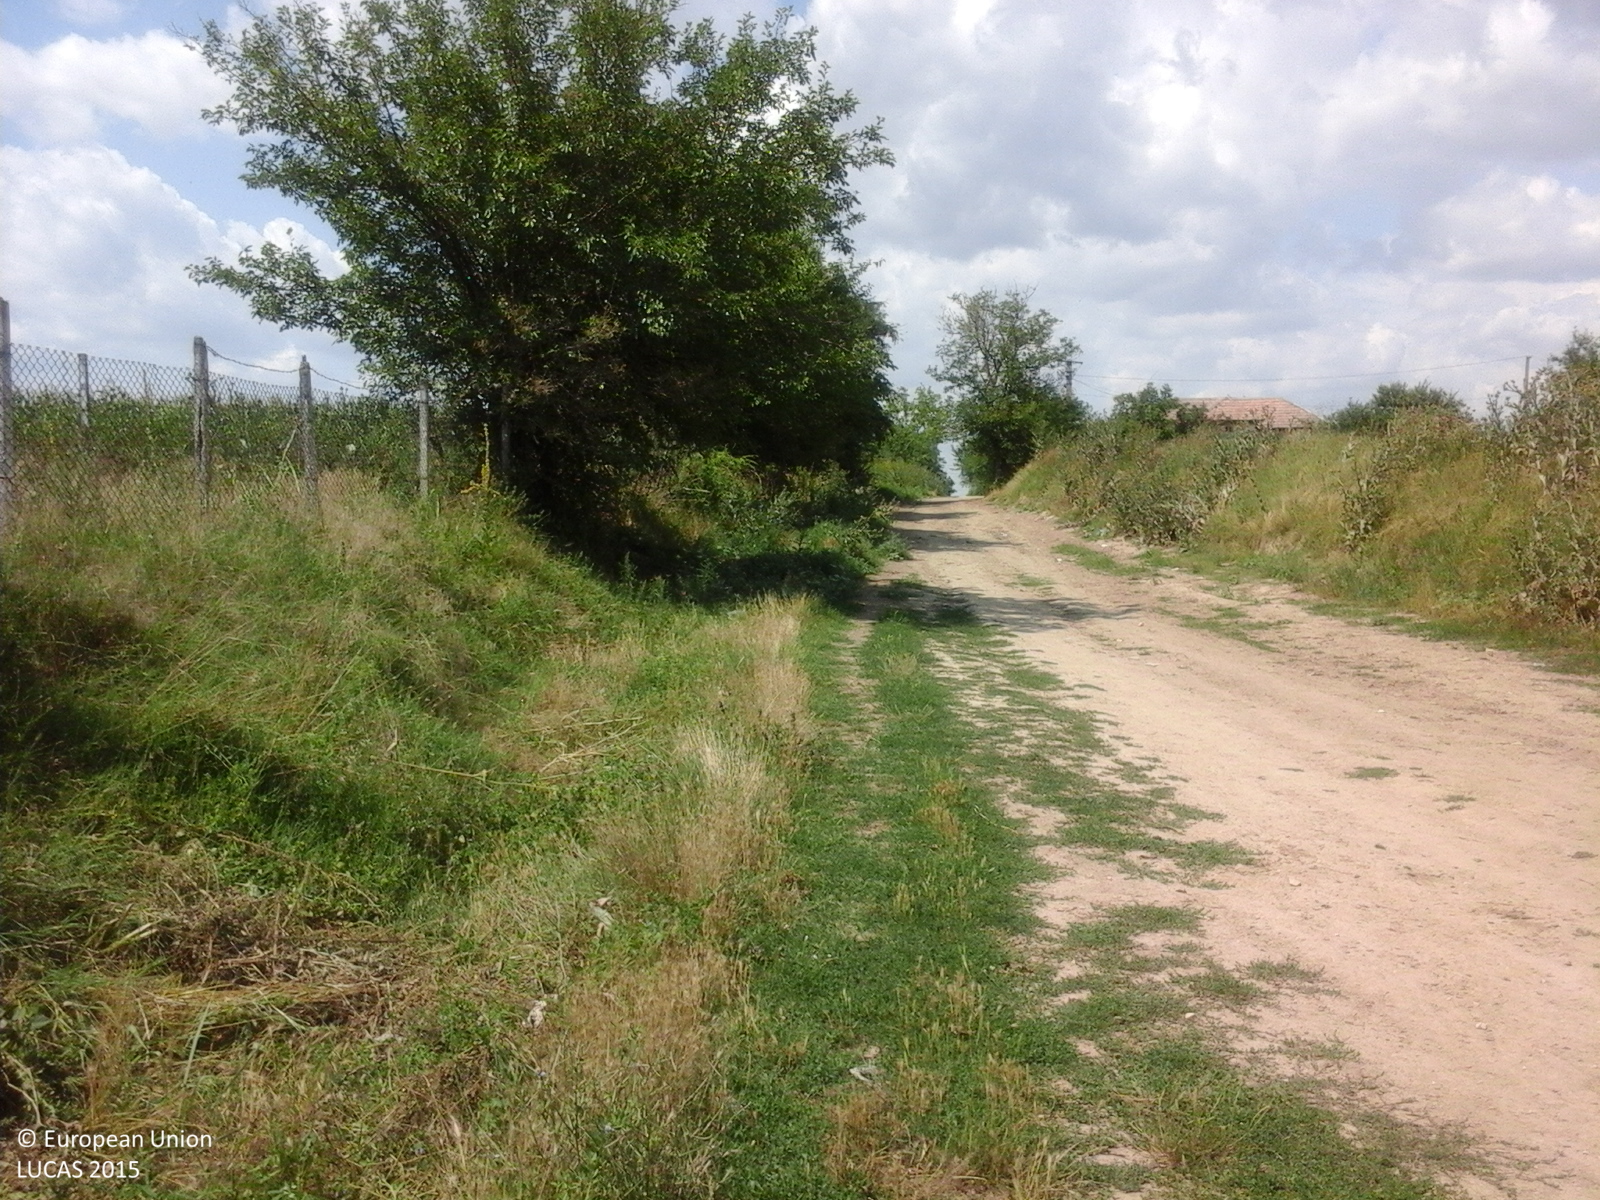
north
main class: Grassland
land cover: Grassland without tree/shrub cover
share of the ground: > 75 %
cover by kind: herbaceous plants 100 %
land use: Agriculture (excluding fallow land and kitchen gardens)
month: July
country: RO
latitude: 43.7489
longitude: 24.3552
